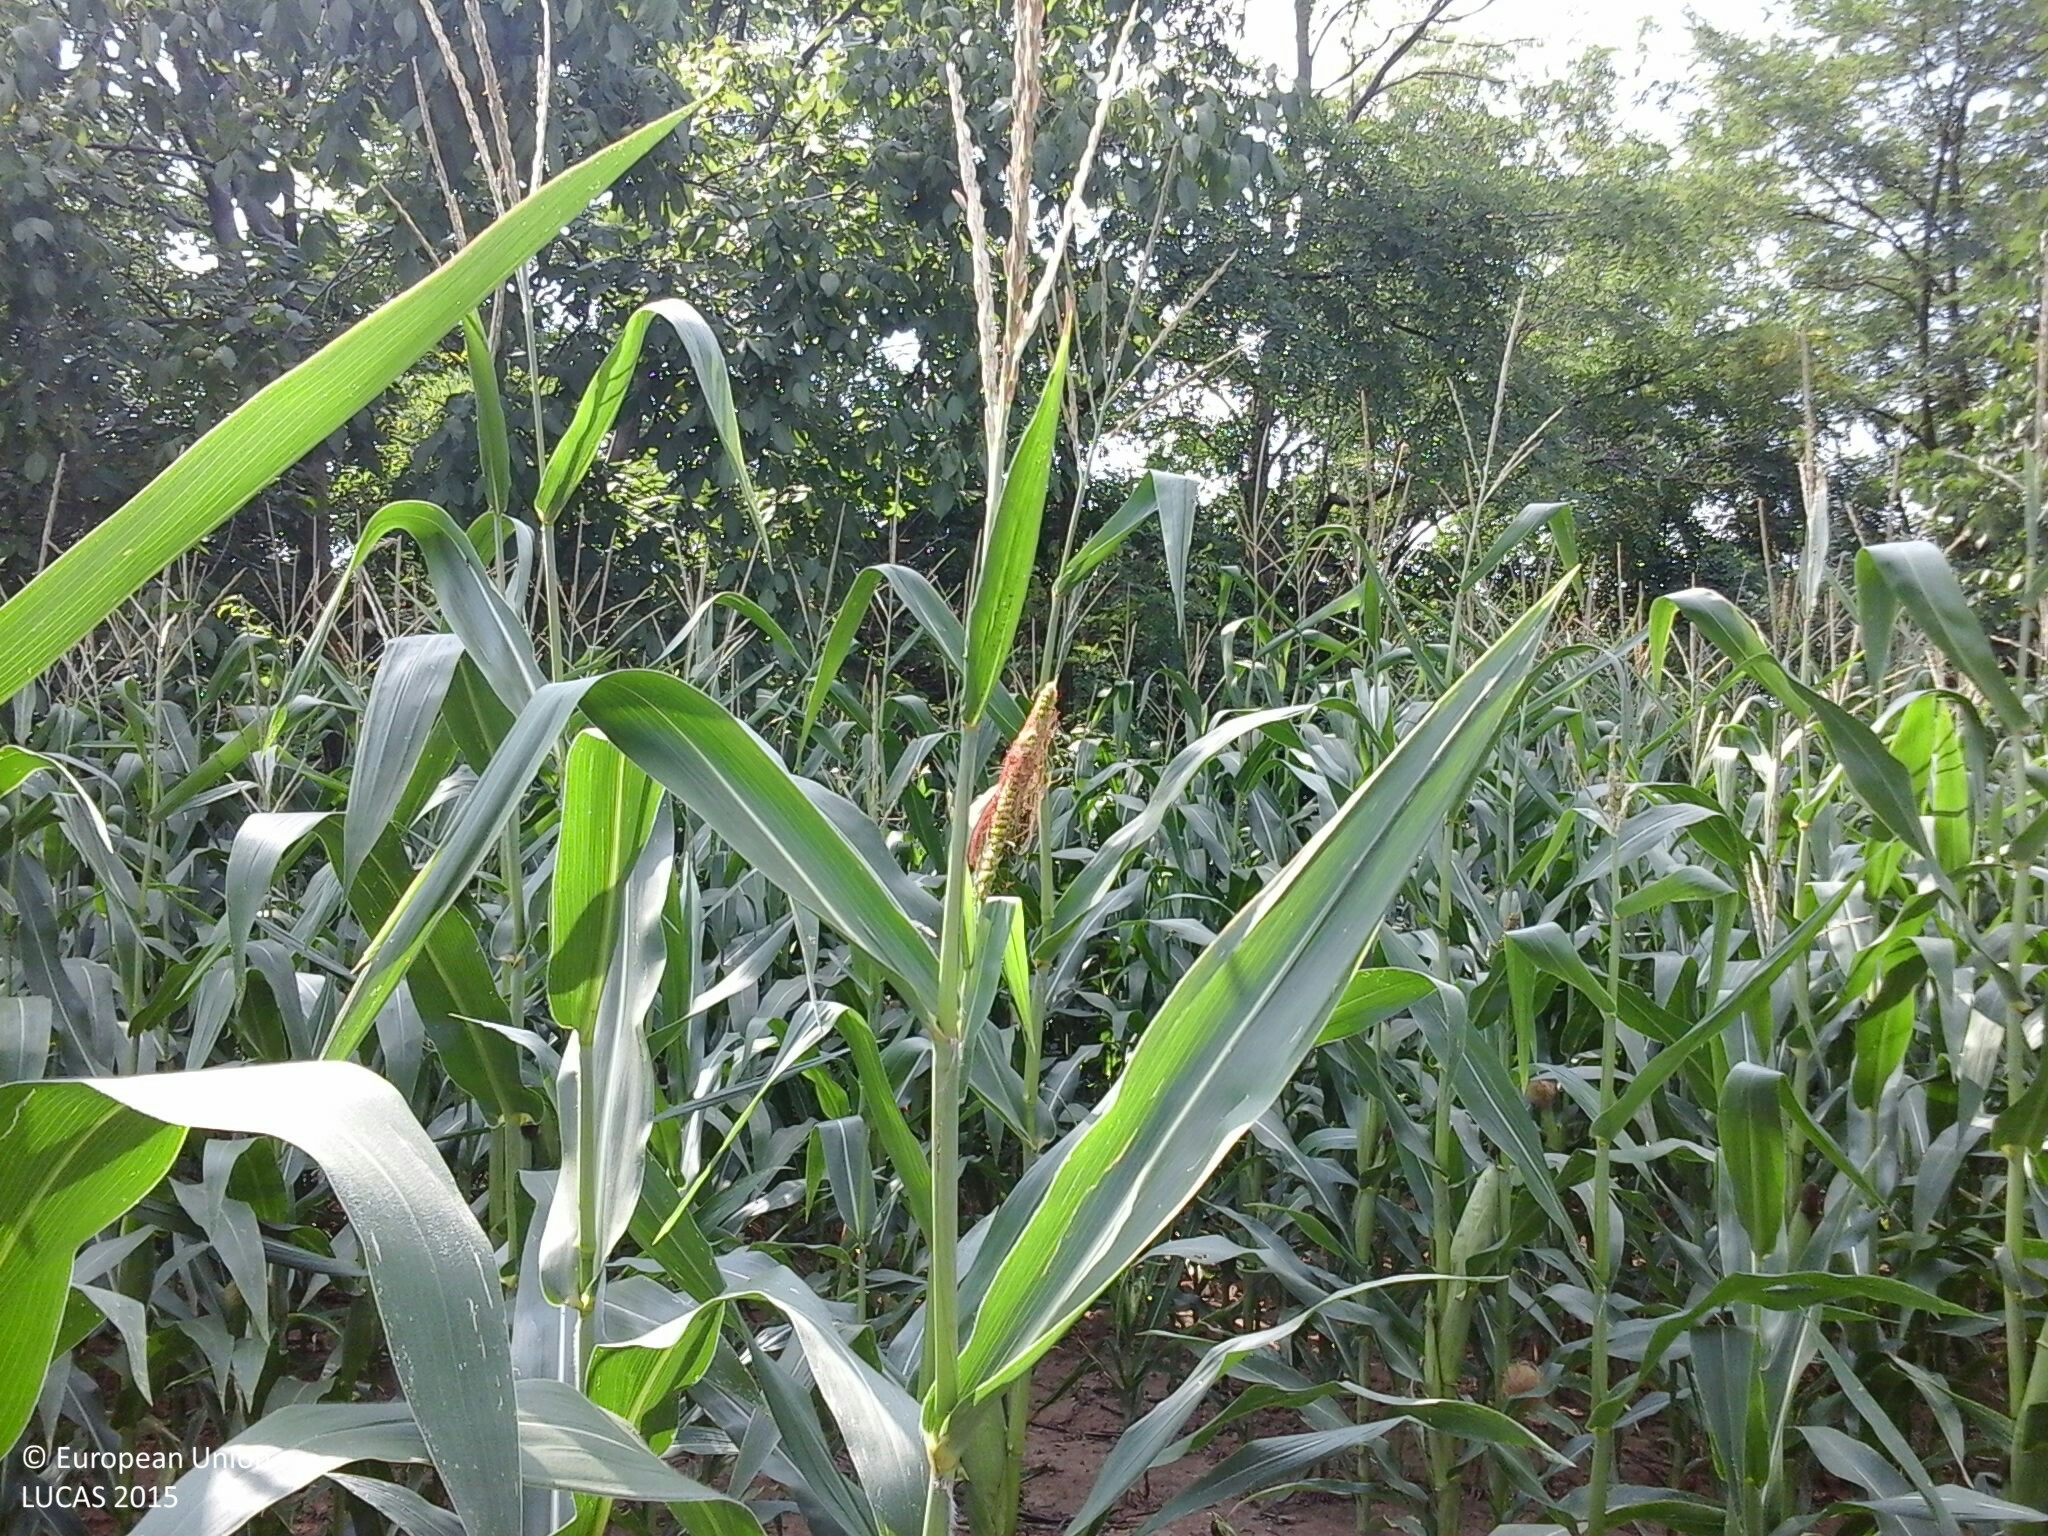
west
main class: Cropland
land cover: Maize
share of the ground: > 75 %
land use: Agriculture (excluding fallow land and kitchen gardens)
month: August
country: HU
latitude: 45.9138
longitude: 18.1412
